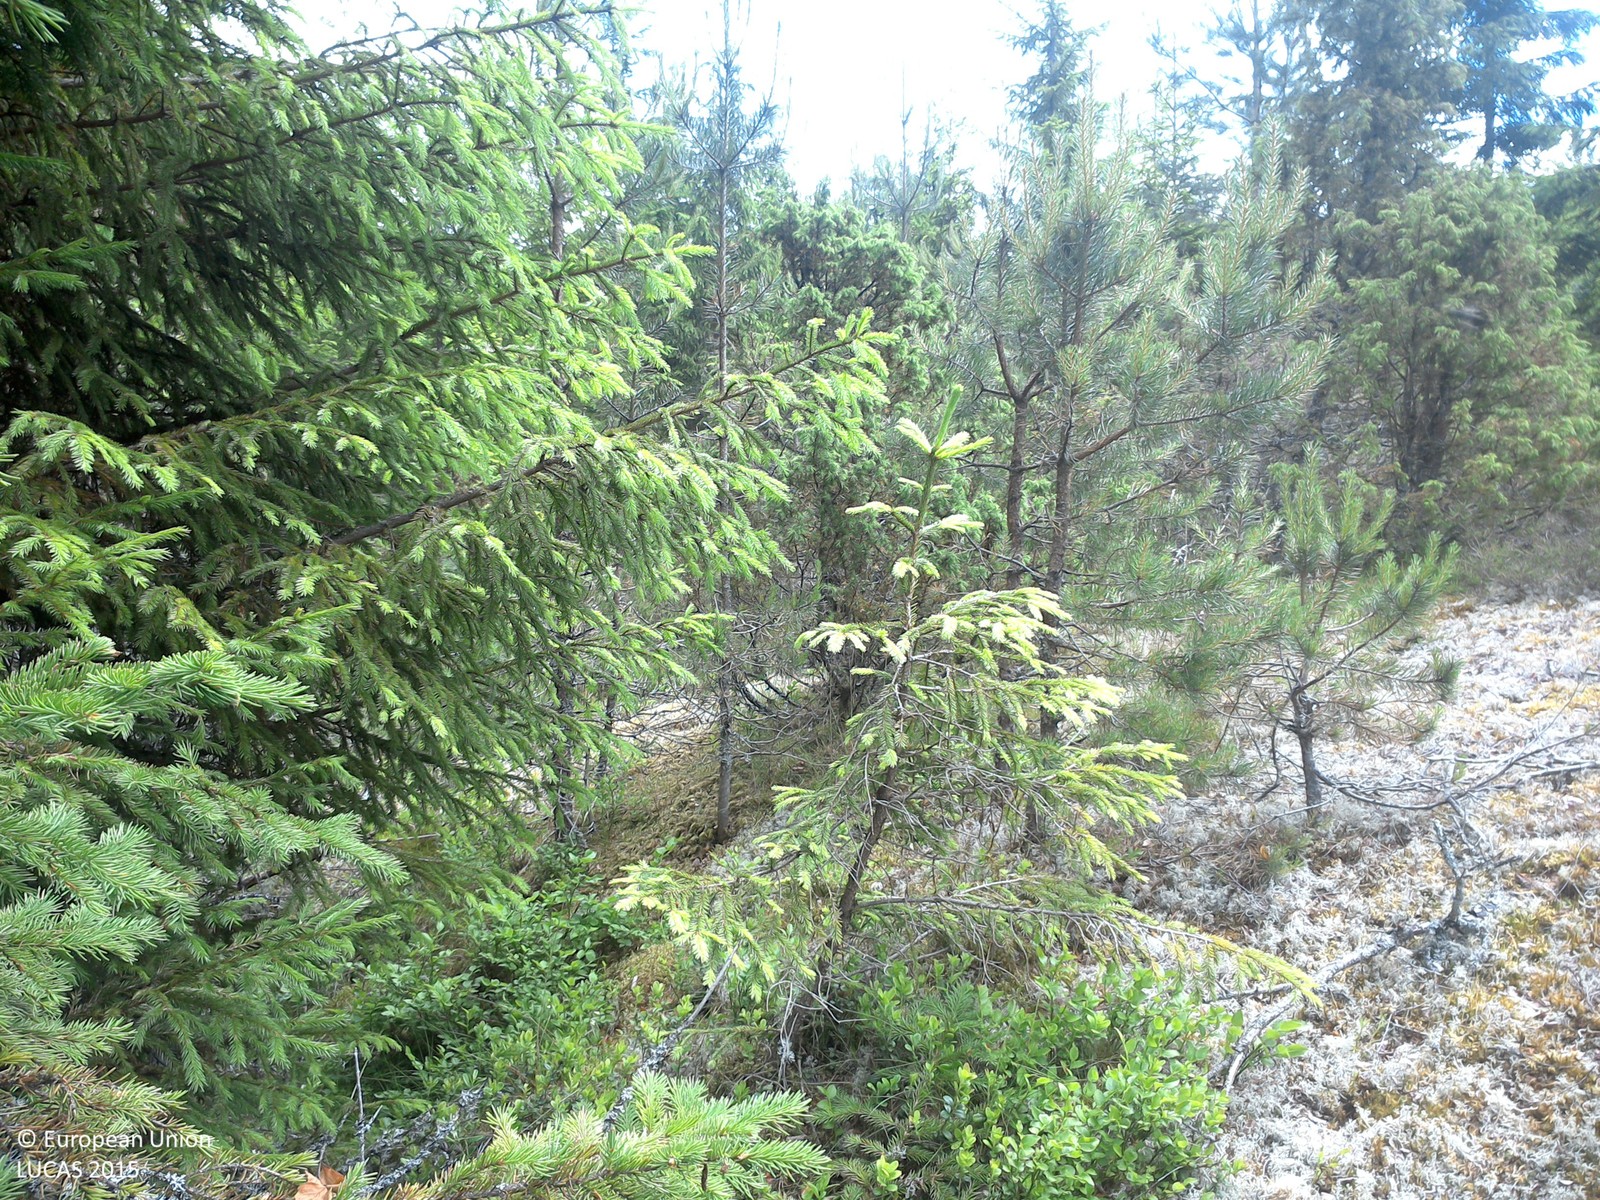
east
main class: Woodland
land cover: Spruce dominated coniferous woodland
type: boreal forest
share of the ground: 50 - 75 %
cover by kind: coniferous forest trees 75 %, lichens and mosses 20 %, herbaceous plants 5 %
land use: Forestry
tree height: > 5 m
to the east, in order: Spruce dominated coniferous woodland; Paved roads, cycling and walking lanes; Tracks; Spruce dominated coniferous woodland; Tracks; Pine dominated coniferous woodland
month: June
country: SE
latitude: 57.9968
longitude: 15.9683
